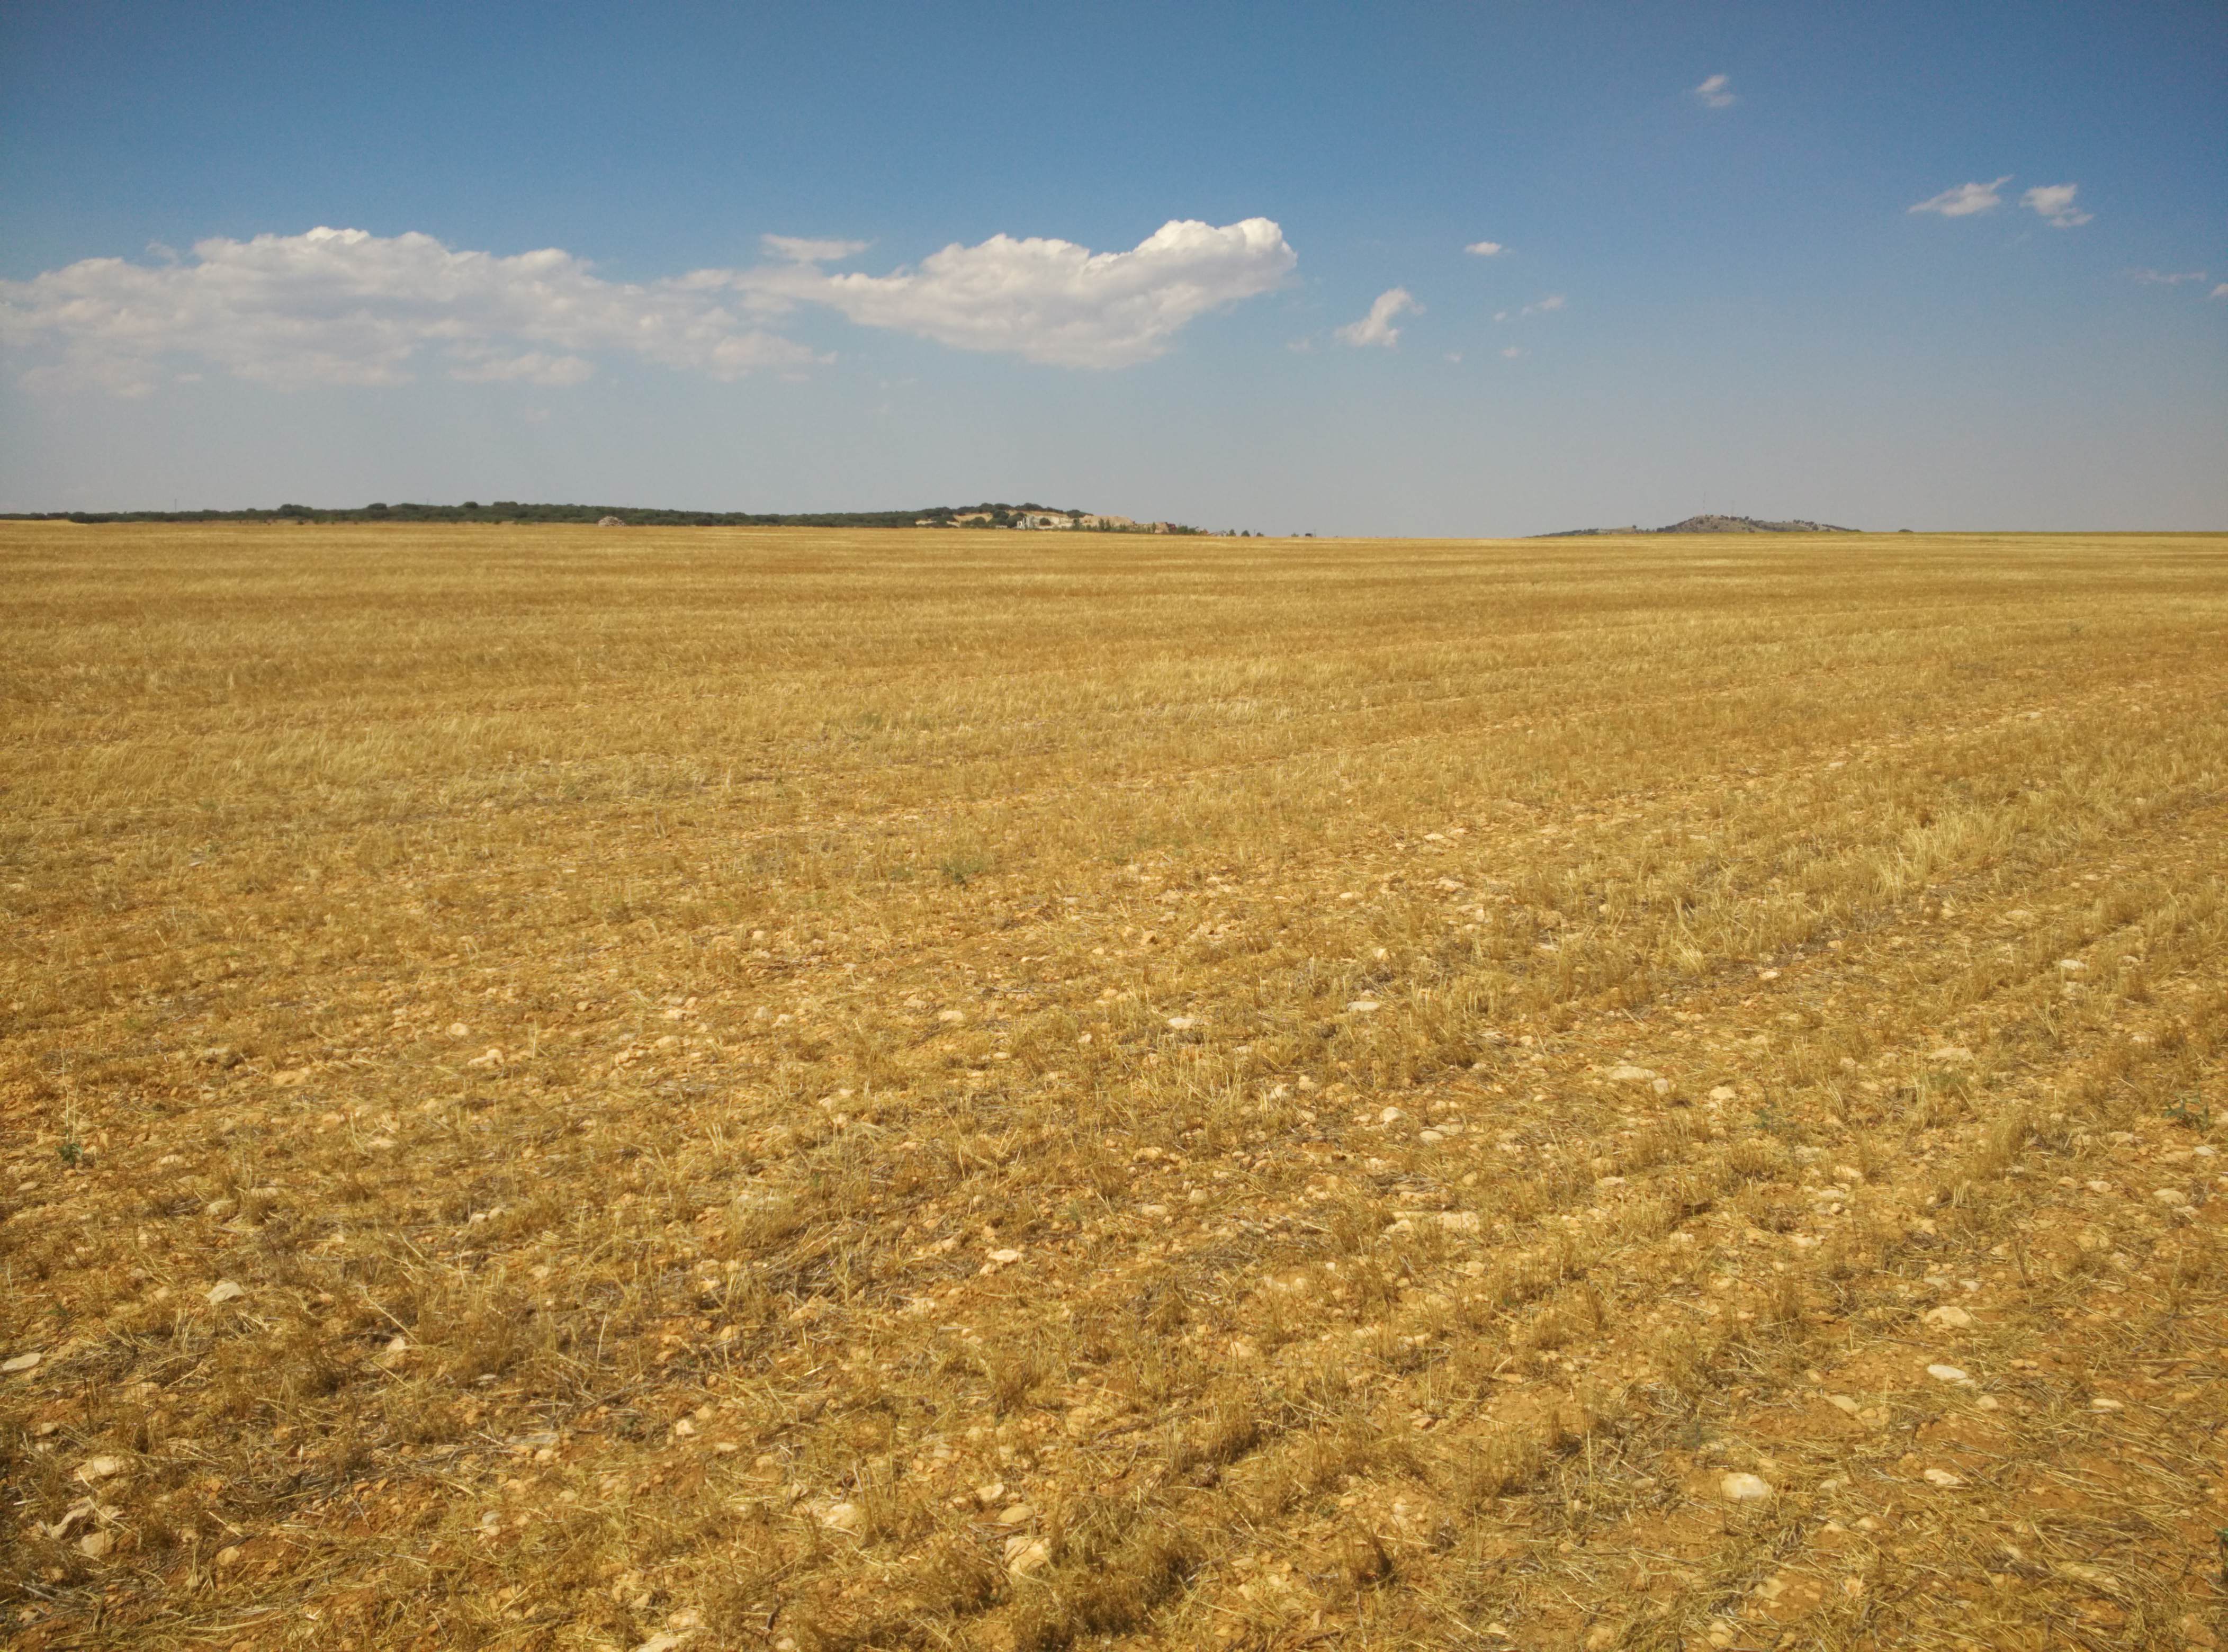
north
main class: Cropland
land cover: Dry pulses
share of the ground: < 10 %
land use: Agriculture (excluding fallow land and kitchen gardens)
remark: Harvested field
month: July
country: ES
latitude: 40.9401
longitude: -2.6812
